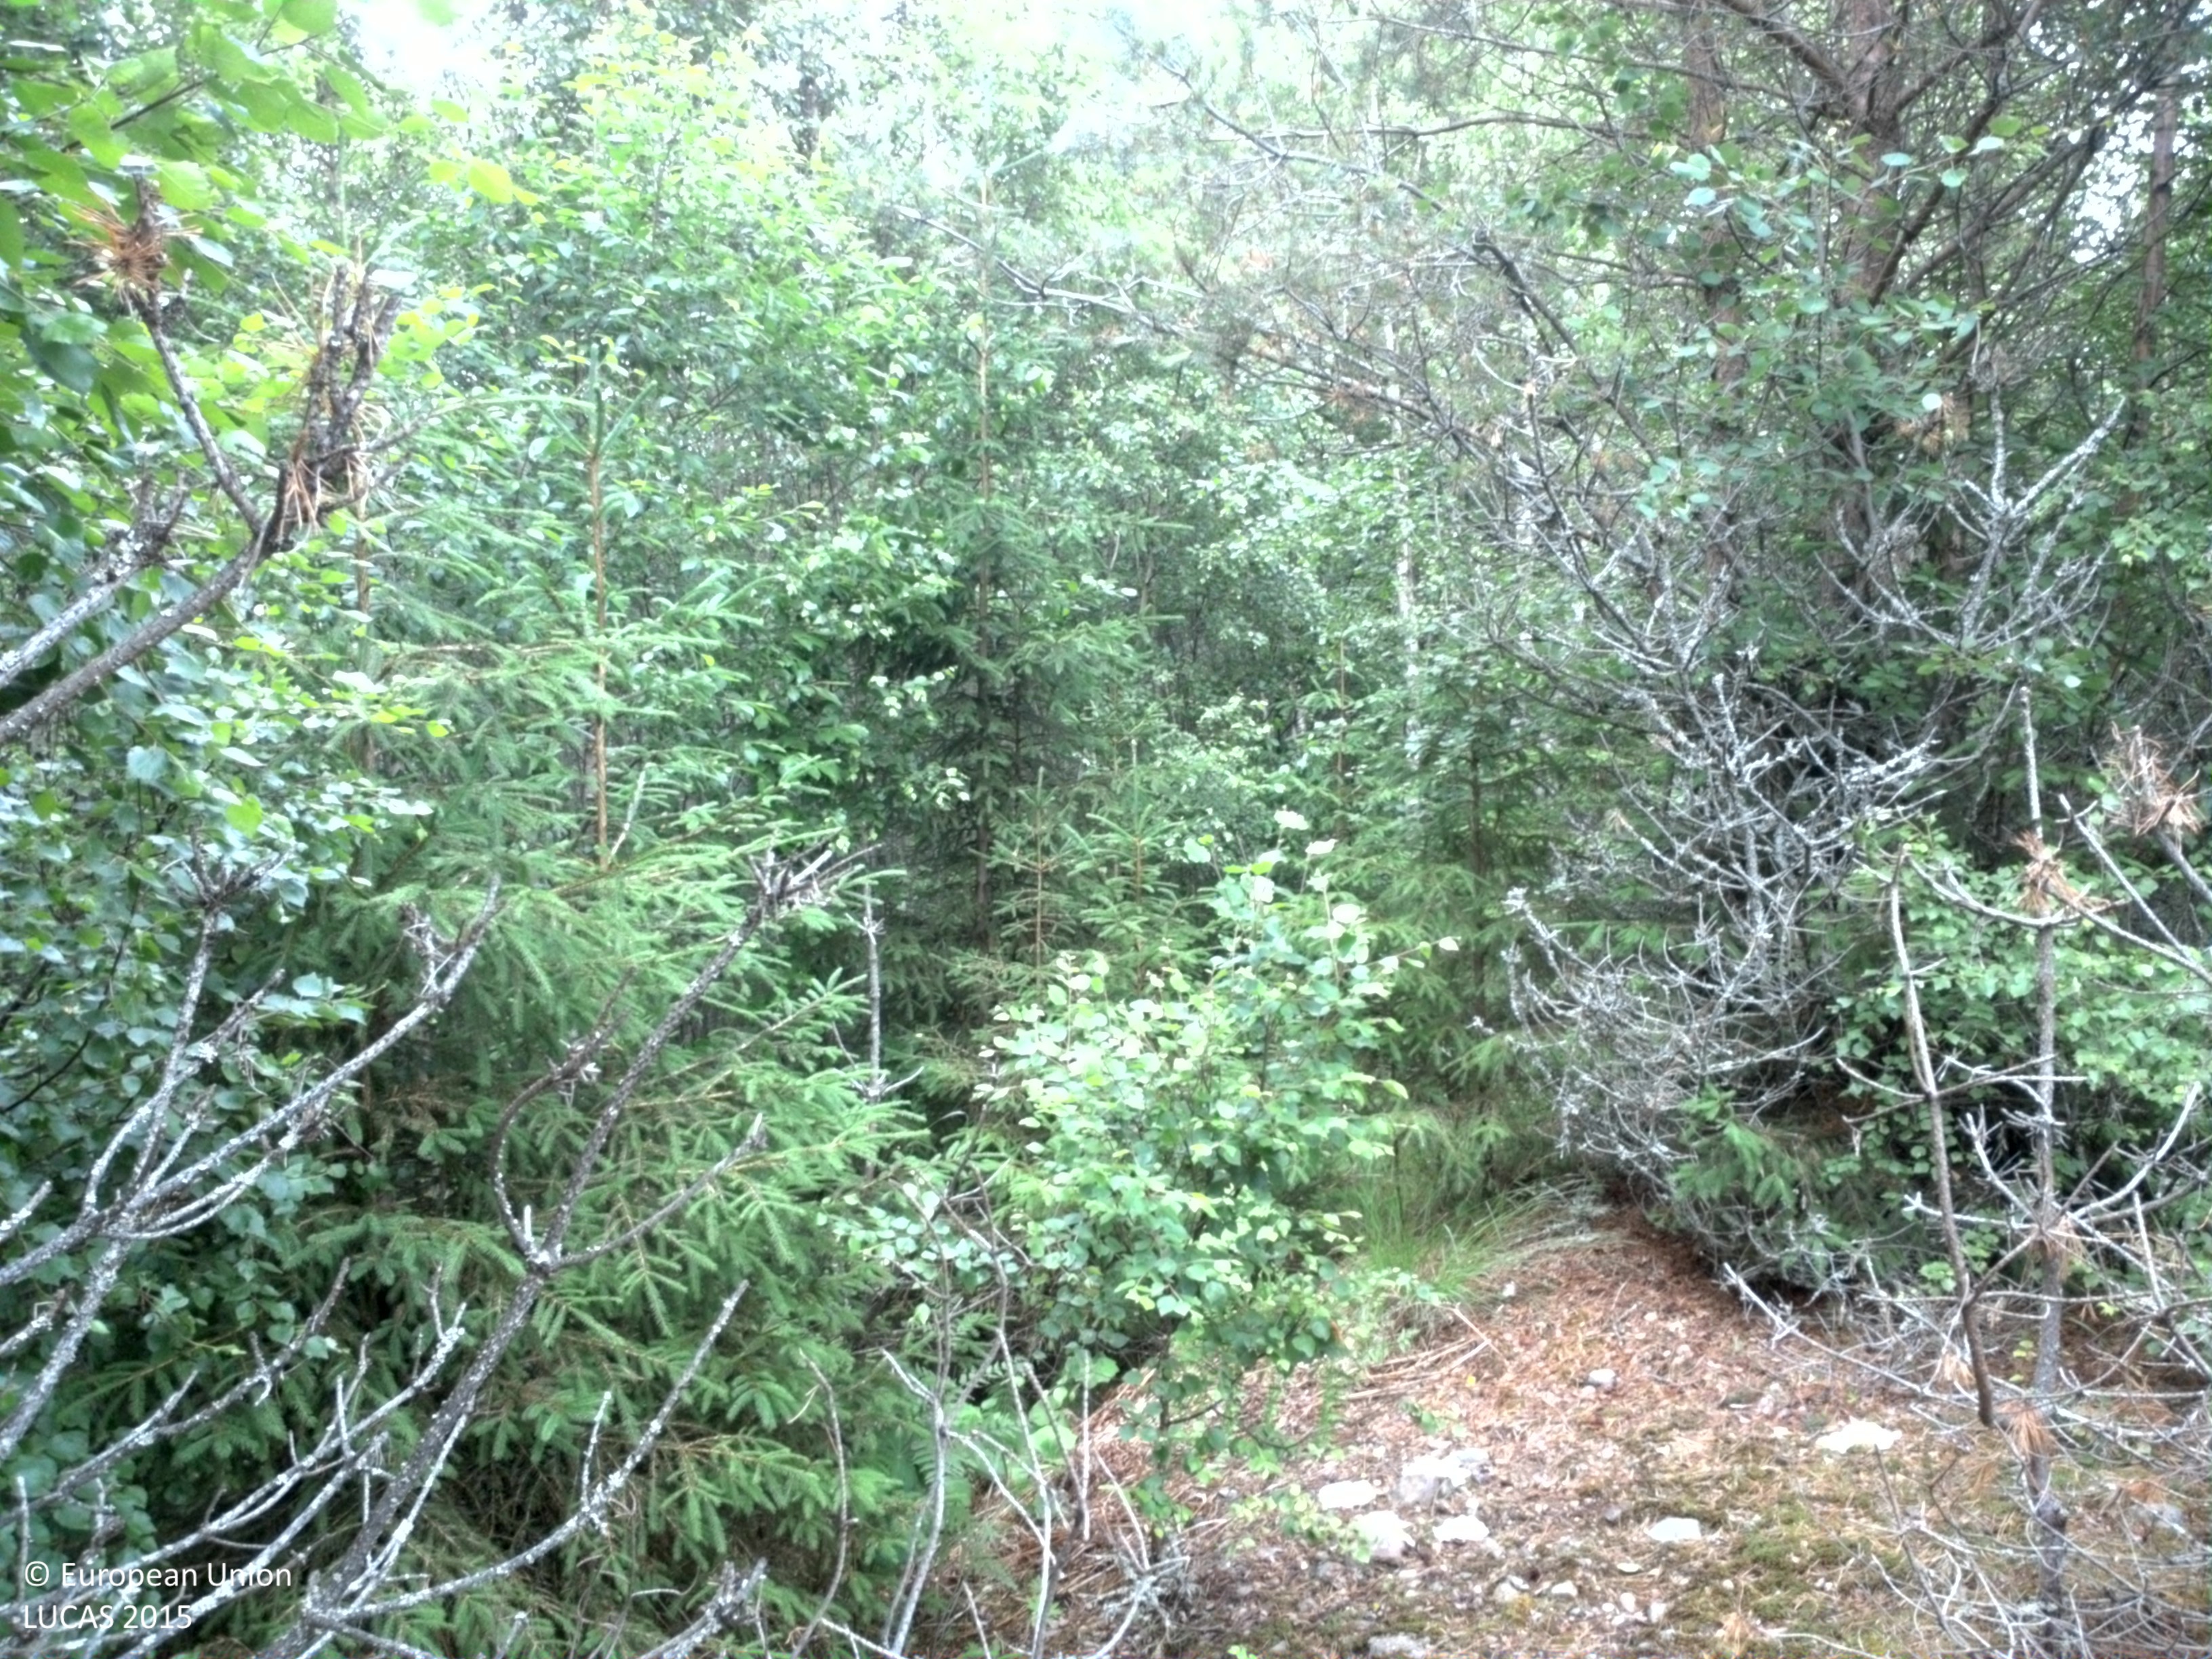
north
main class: Woodland
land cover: Pine dominated coniferous woodland
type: boreal forest
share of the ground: 10 - 25 %
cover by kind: consolidated bare surface 65 %, coniferous forest trees 20 %, broadleaved forest trees 5 %, shrubs 5 %, lichens and mosses 5 %
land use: Forestry
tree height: < 5 m
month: July
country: SE
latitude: 59.2959
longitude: 12.3996
